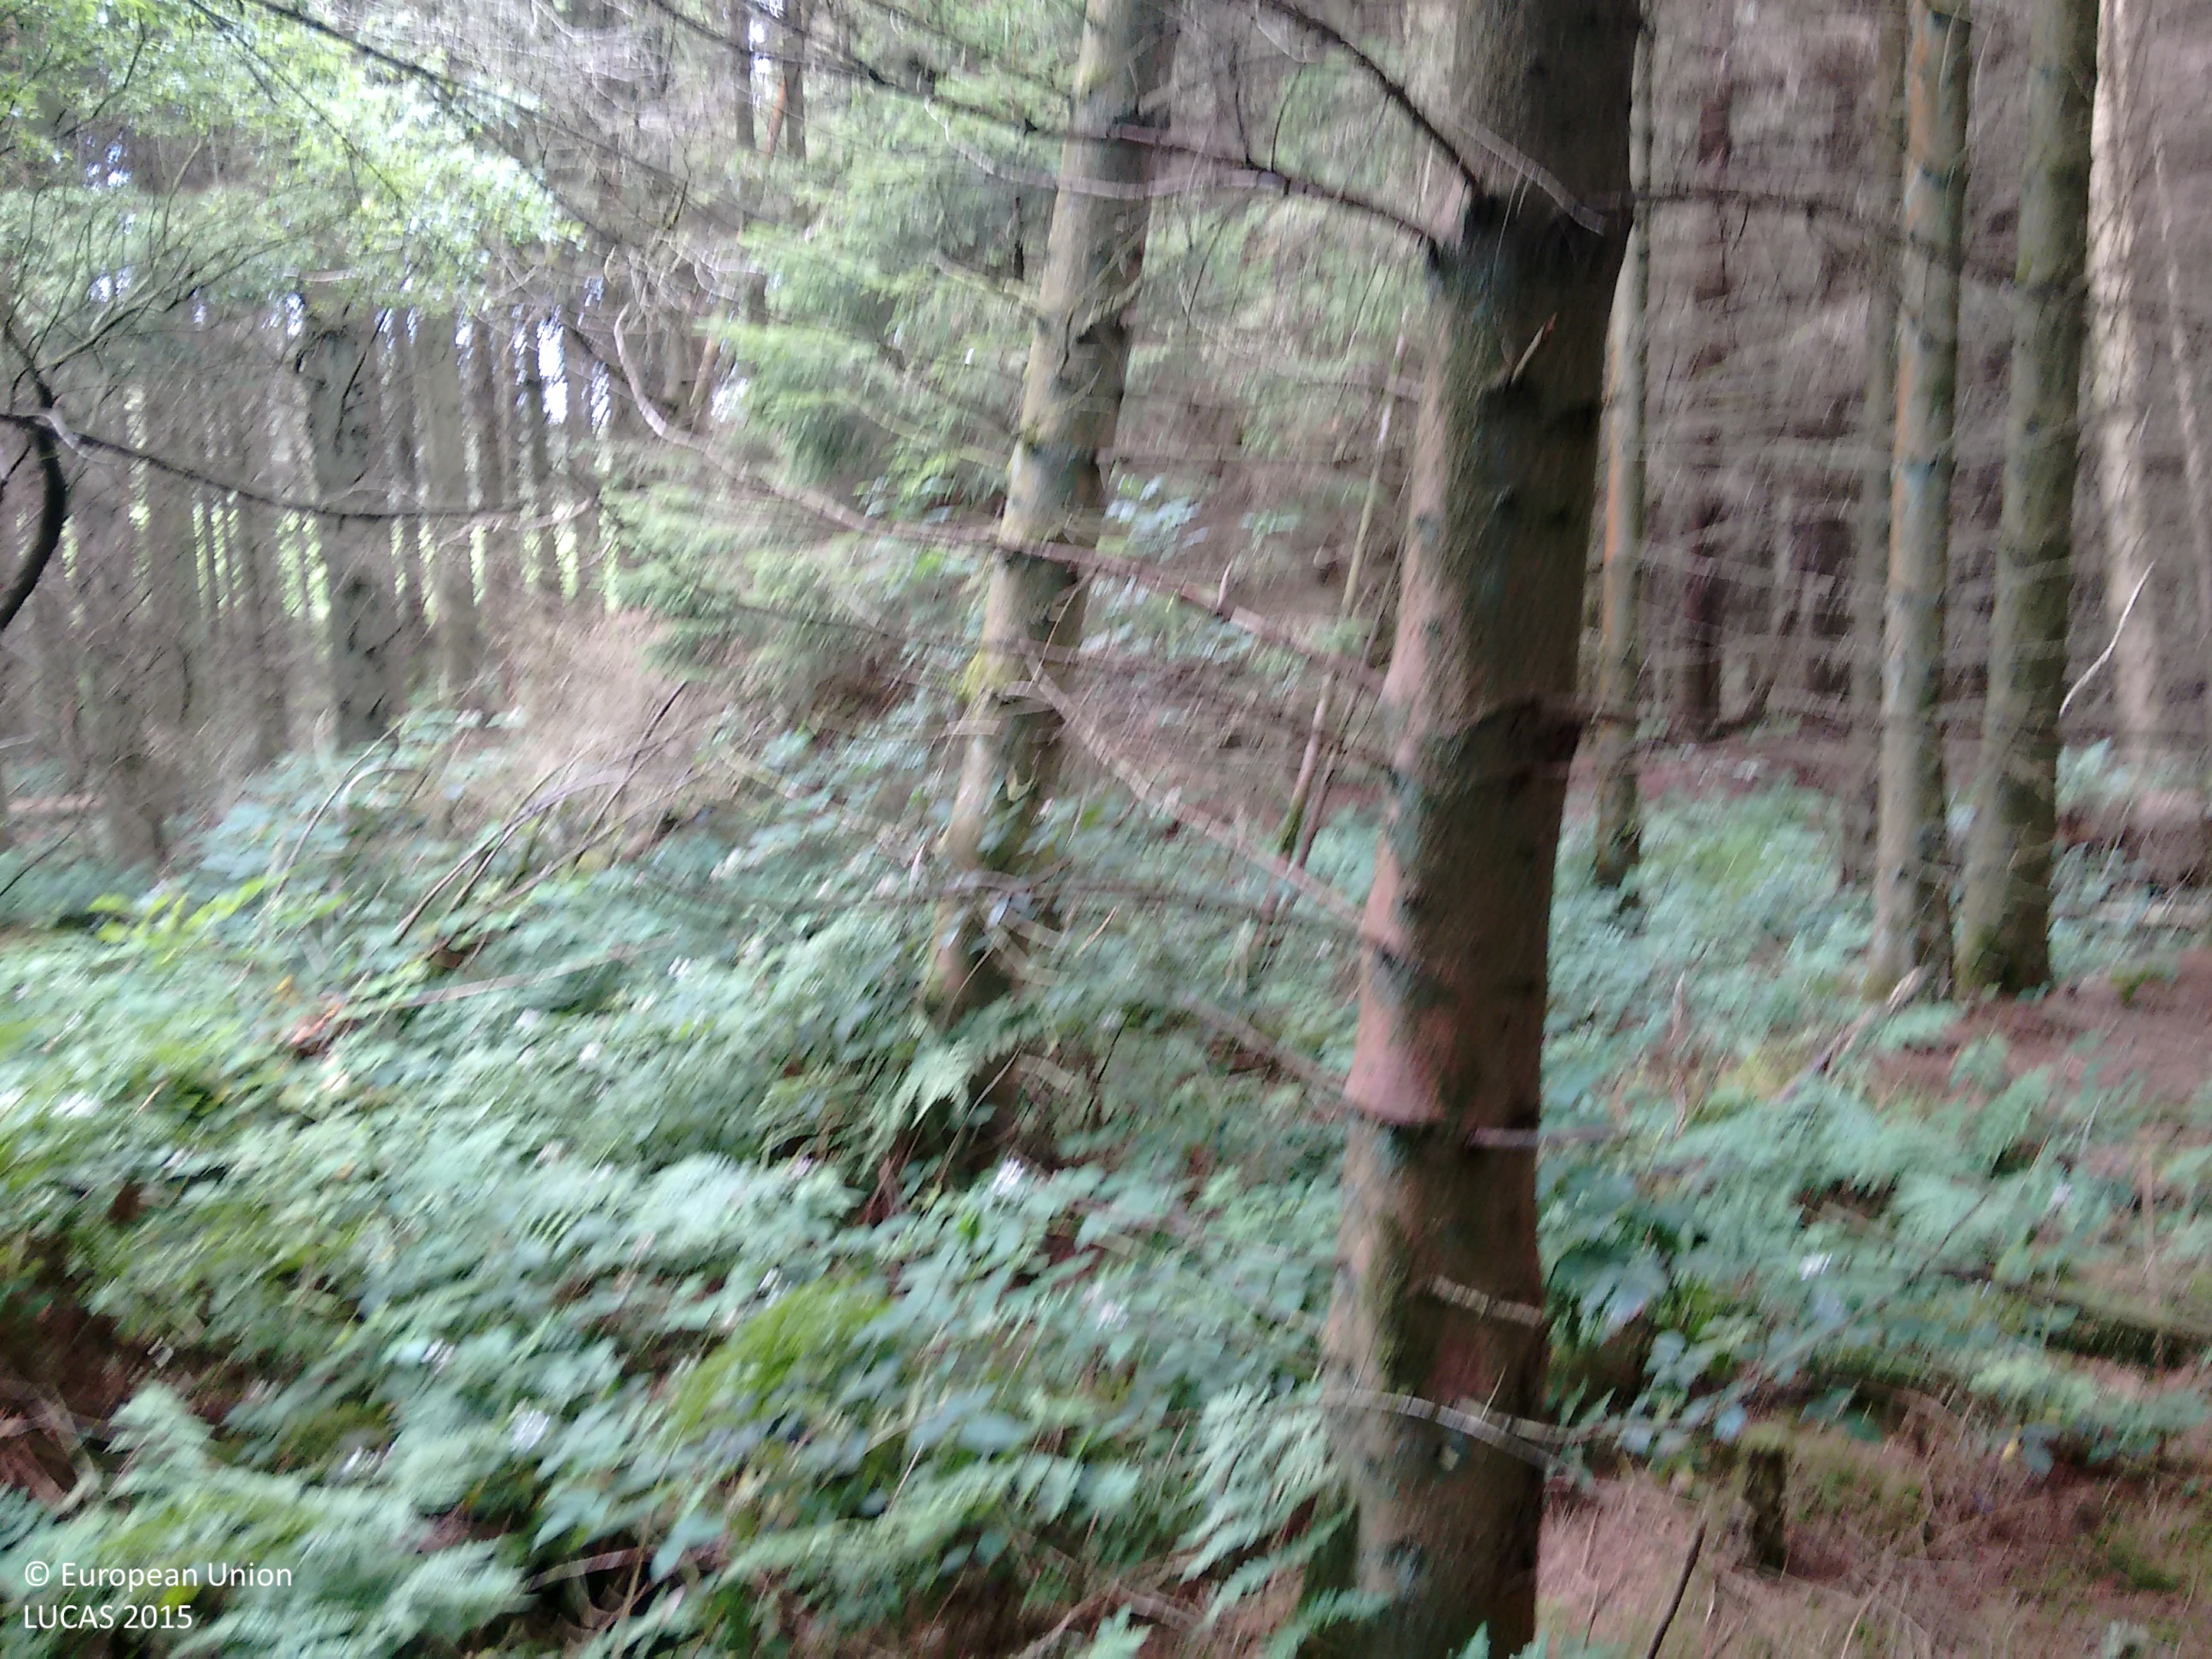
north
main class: Woodland
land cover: Spruce dominated mixed woodland
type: exotic forest
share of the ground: > 75 %
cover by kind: coniferous forest trees 75 %, broadleaved forest trees 25 %
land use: Forestry
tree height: > 5 m
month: August
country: GB
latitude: 53.0435
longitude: -3.4930
